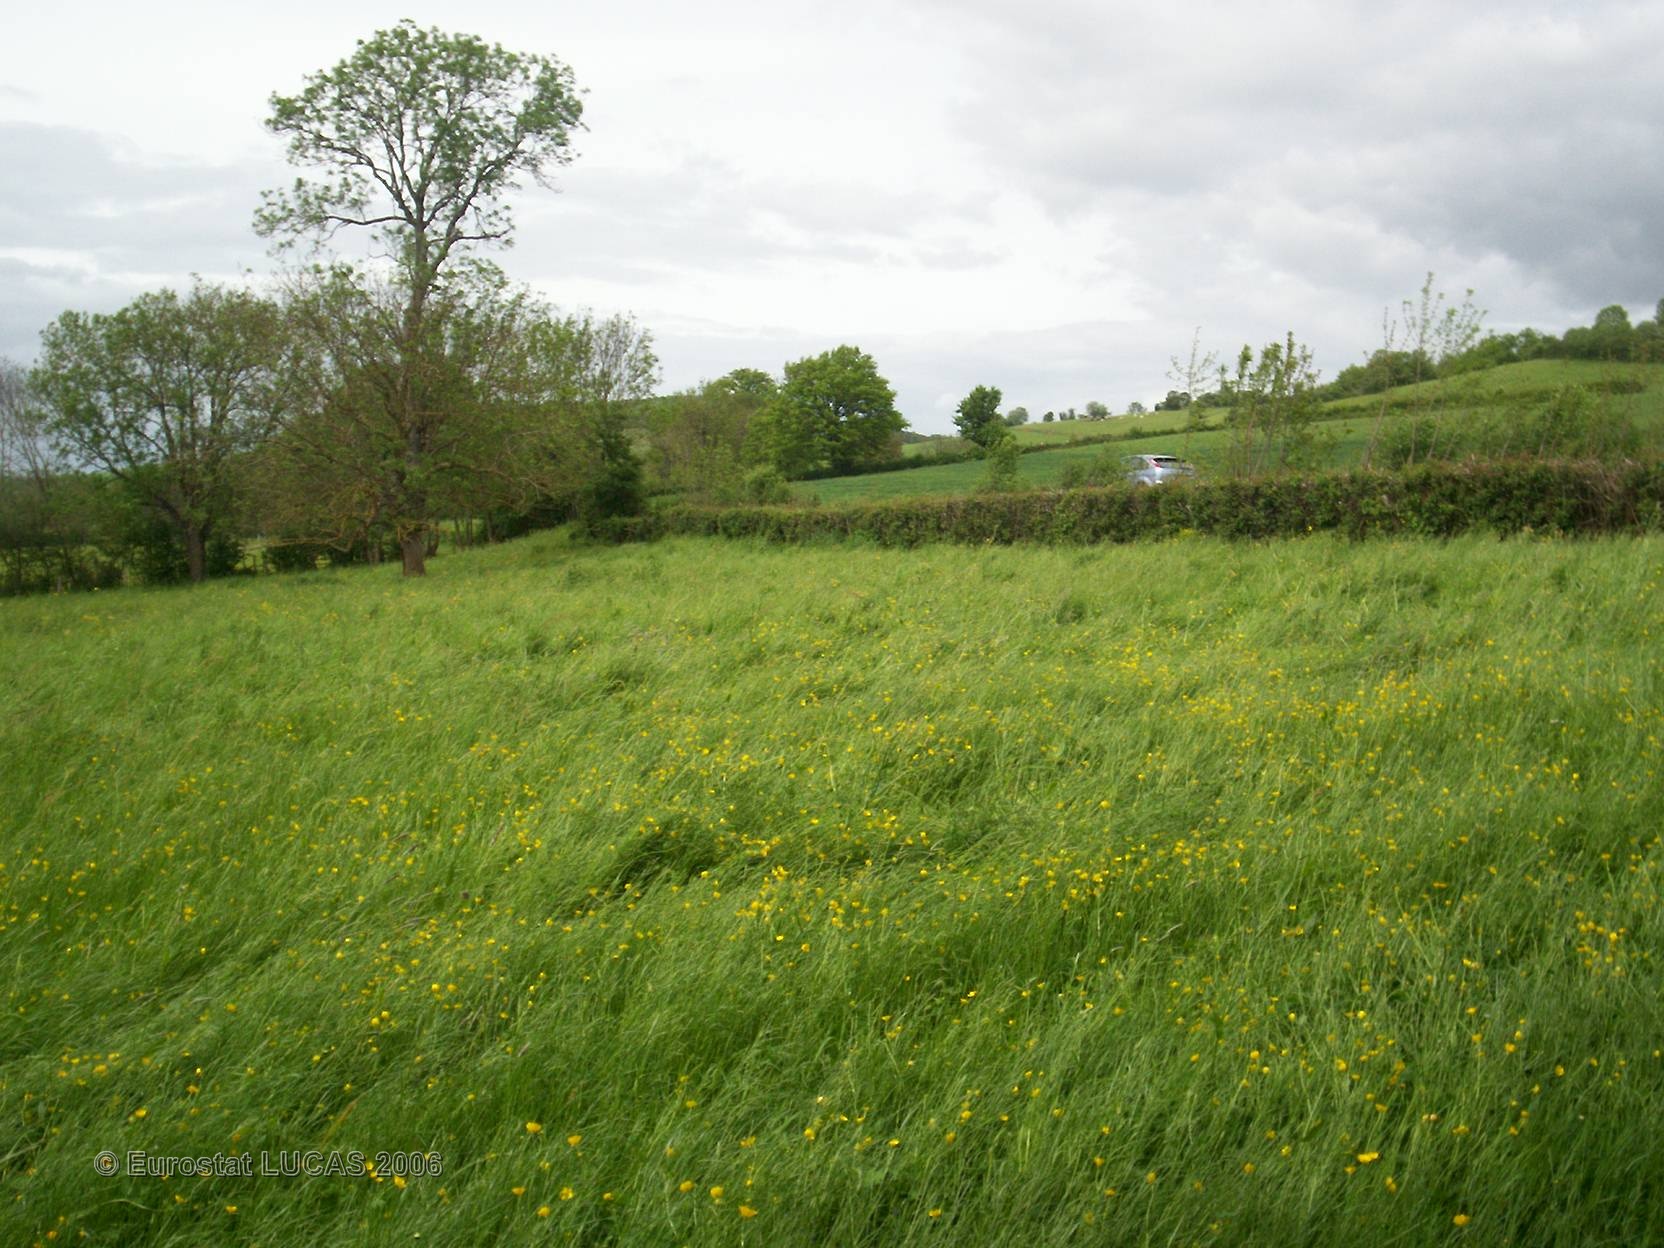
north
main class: Grassland
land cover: Grassland without tree/shrub cover
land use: Agriculture (excluding fallow land and kitchen gardens)
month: May
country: FR
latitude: 47.1189
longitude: 4.6358
